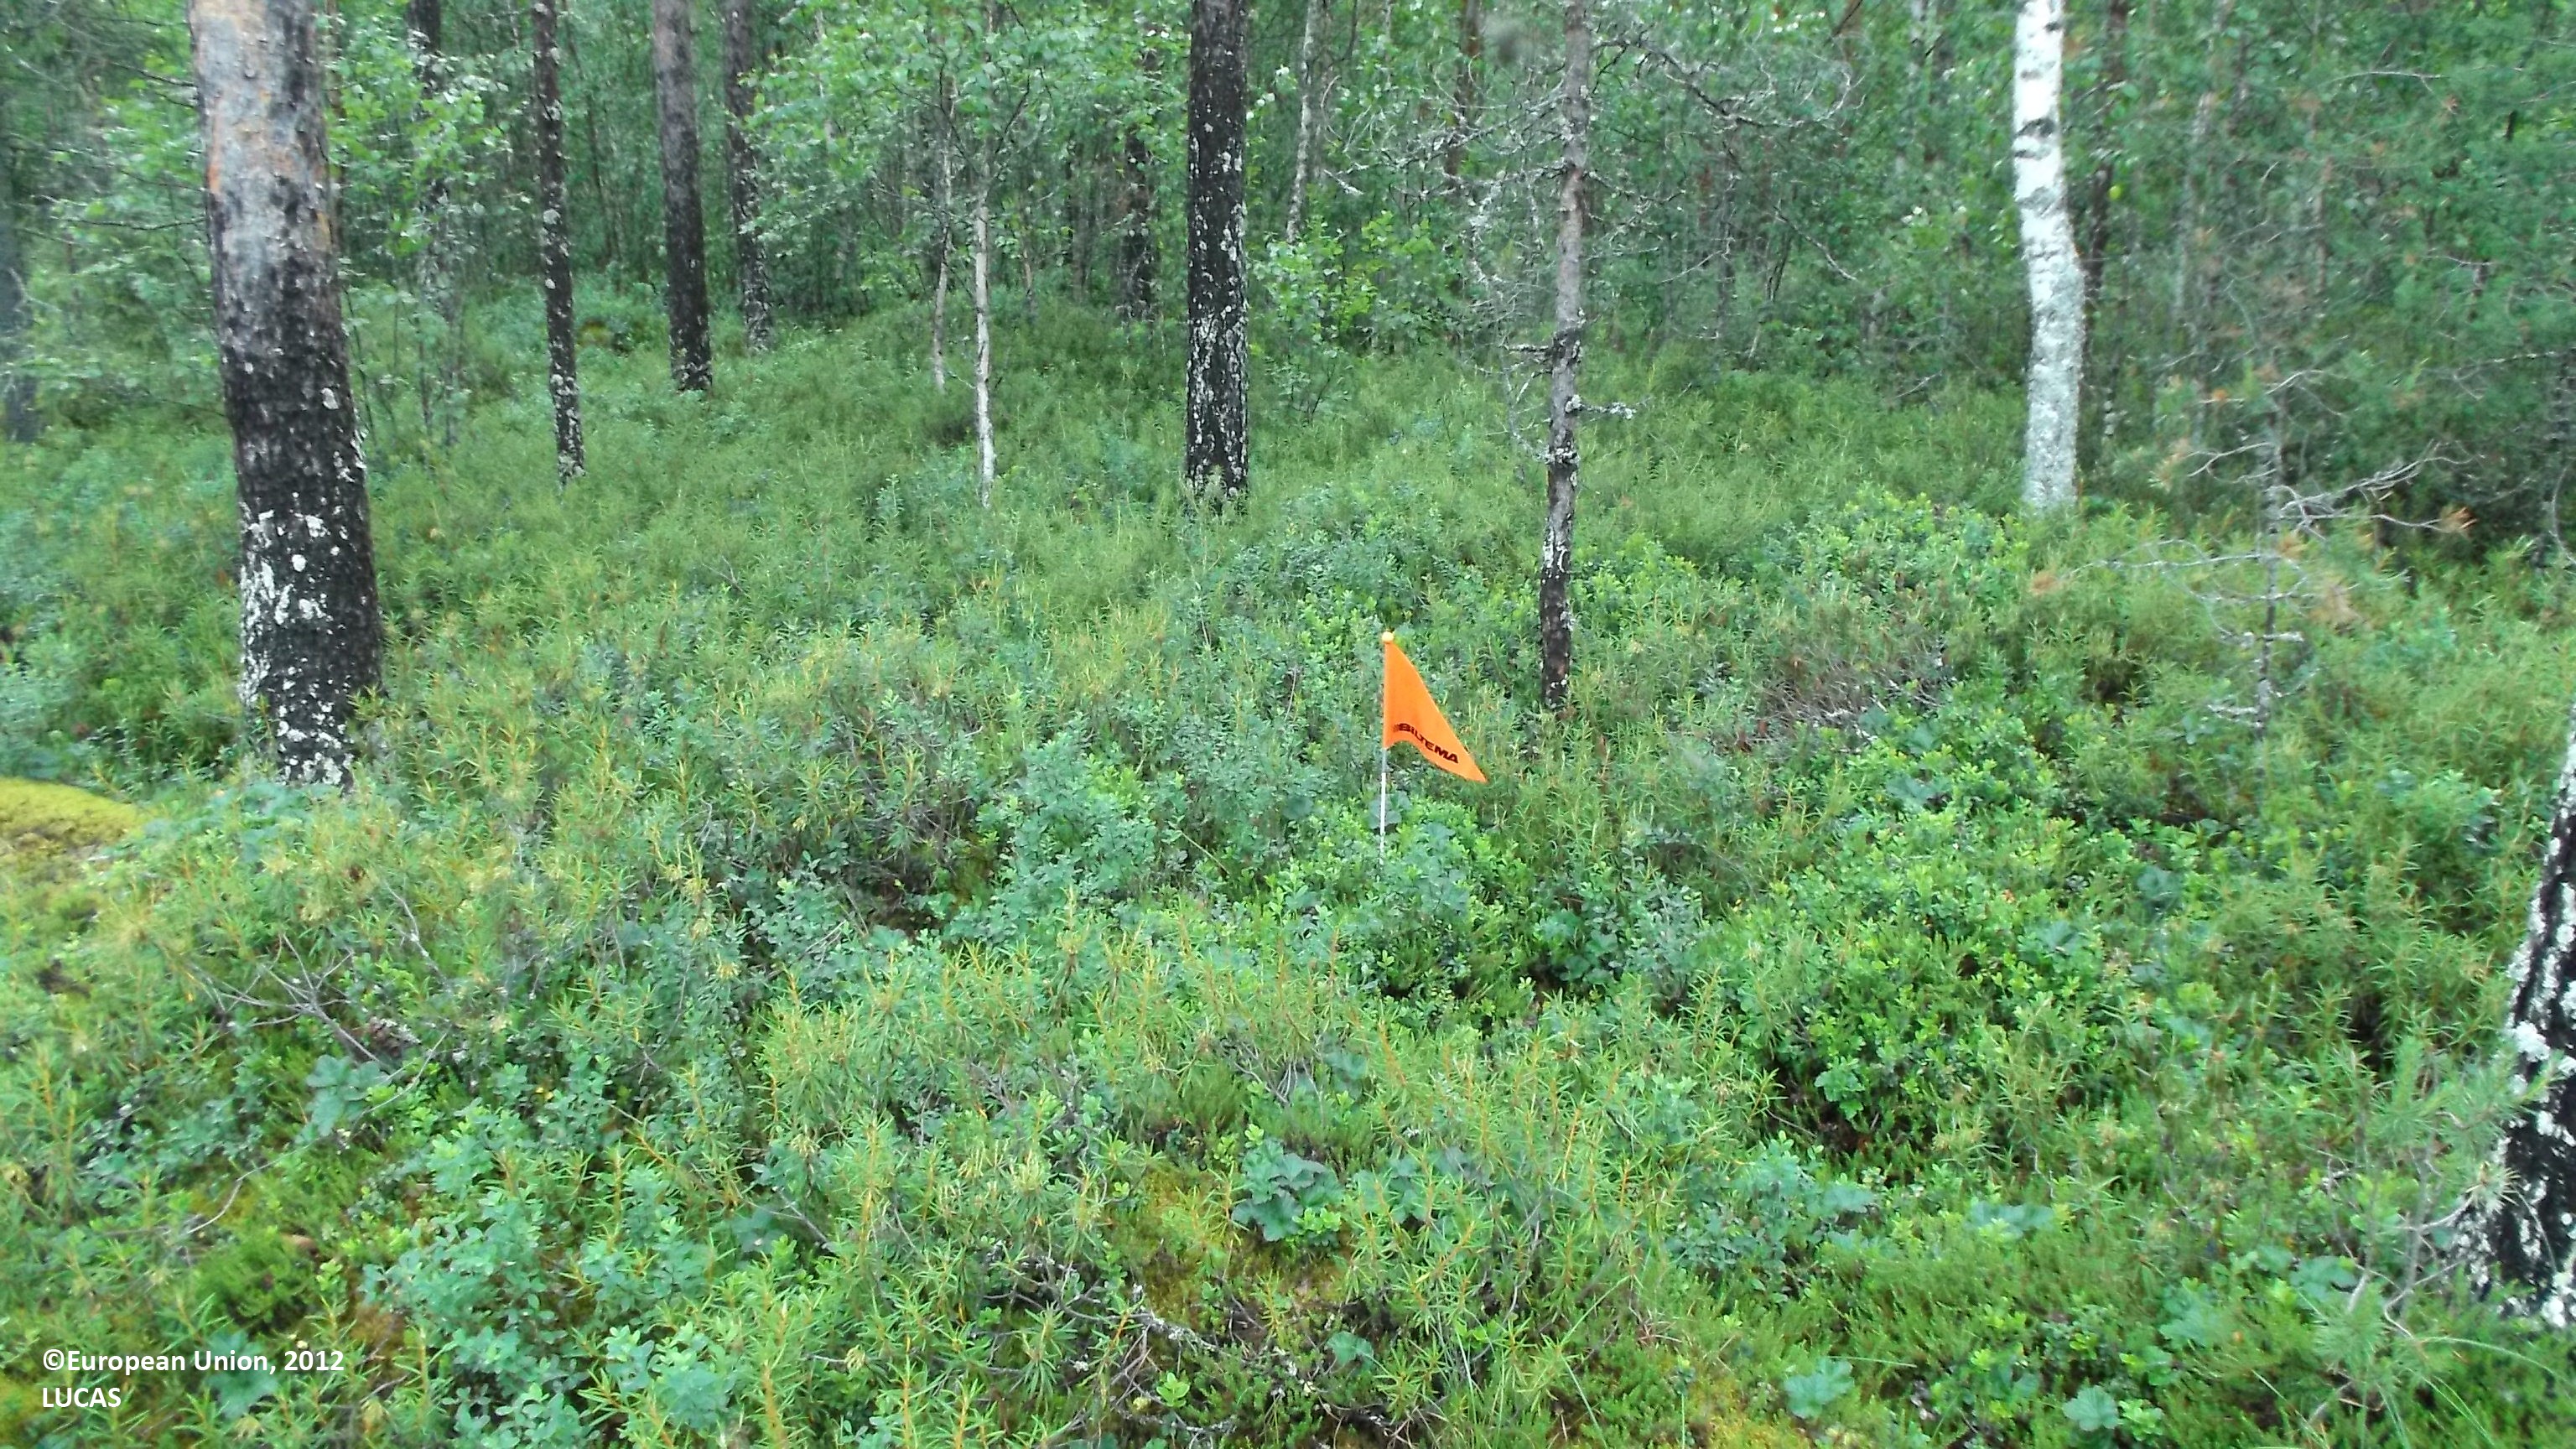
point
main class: Woodland
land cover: Other mixed woodland
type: boreal forest
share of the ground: 50 - 75 %
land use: Forestry
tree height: > 5 m
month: July
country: FI
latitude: 63.3928
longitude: 23.9394
